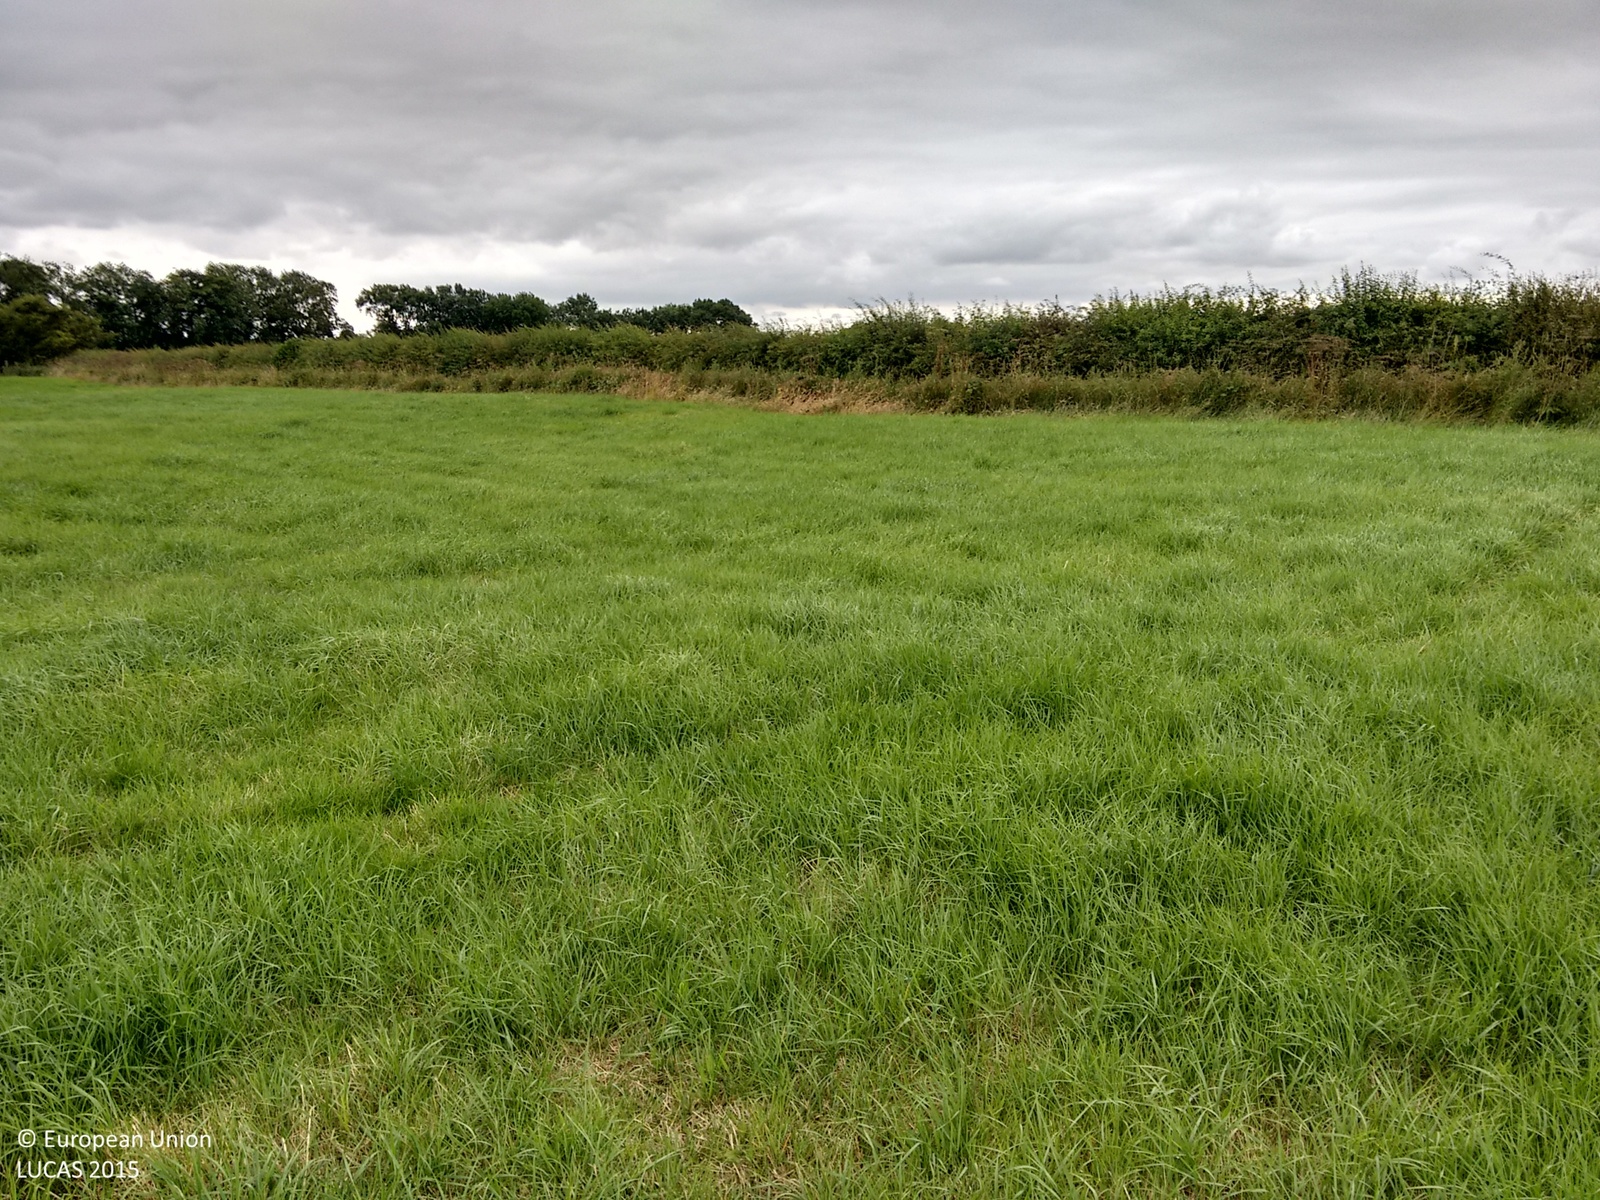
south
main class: Grassland
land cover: Grassland without tree/shrub cover
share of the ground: > 75 %
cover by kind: herbaceous plants 100 %
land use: Agriculture (excluding fallow land and kitchen gardens)
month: July
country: GB
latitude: 52.8416
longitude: -0.8351
